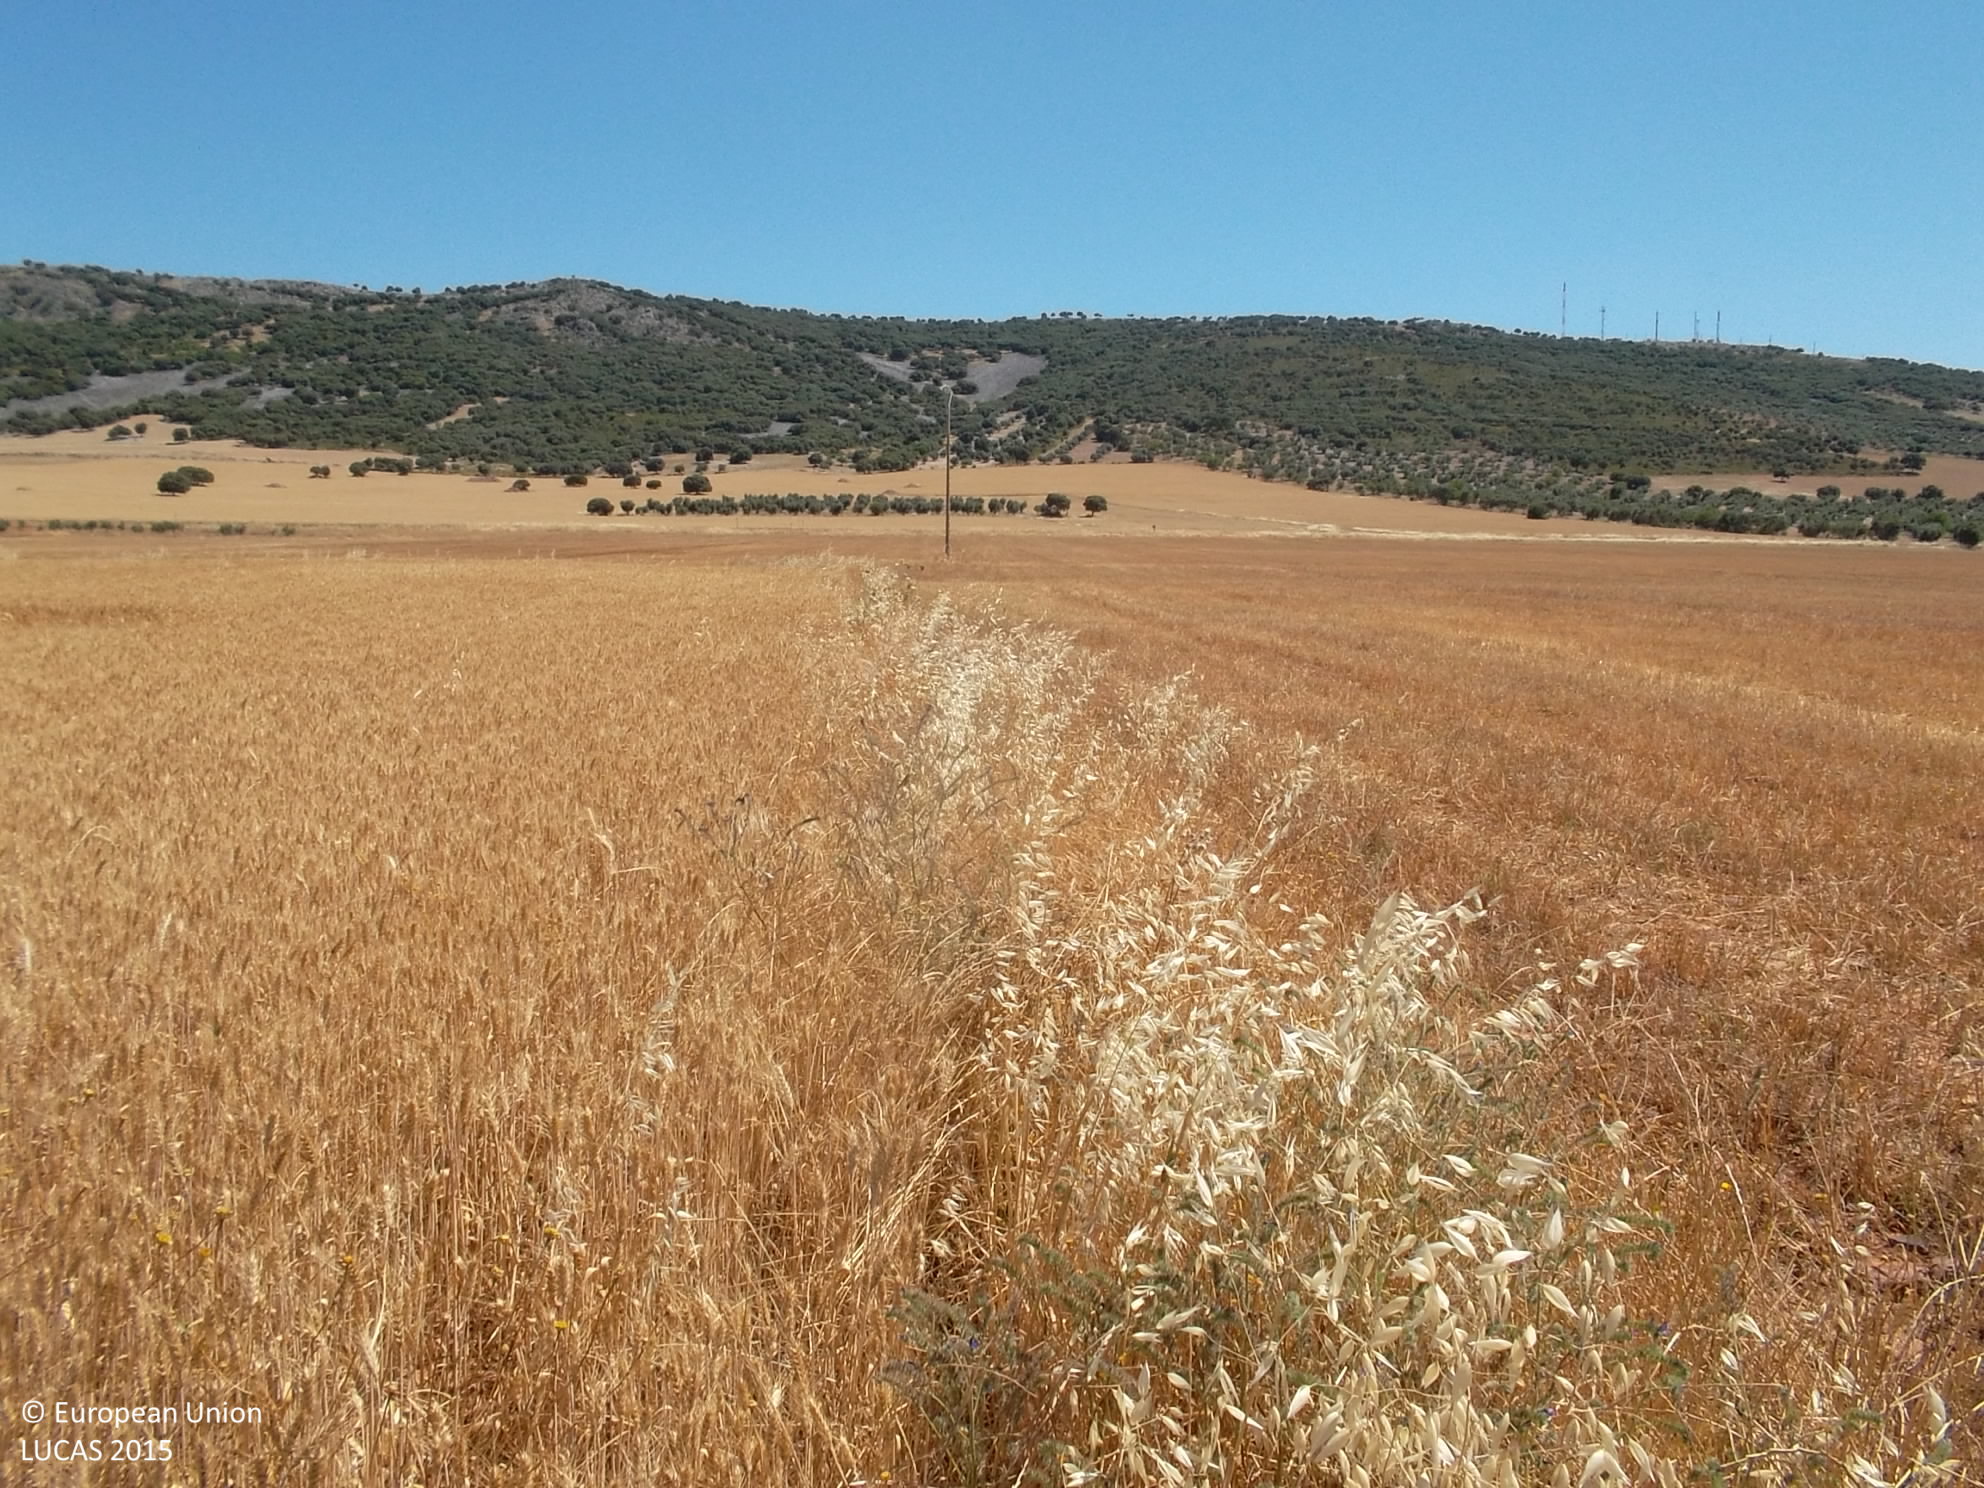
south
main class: Cropland
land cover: Common wheat
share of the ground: 50 - 75 %
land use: Agriculture (excluding fallow land and kitchen gardens)
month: June
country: ES
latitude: 39.1506
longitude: -4.1075
